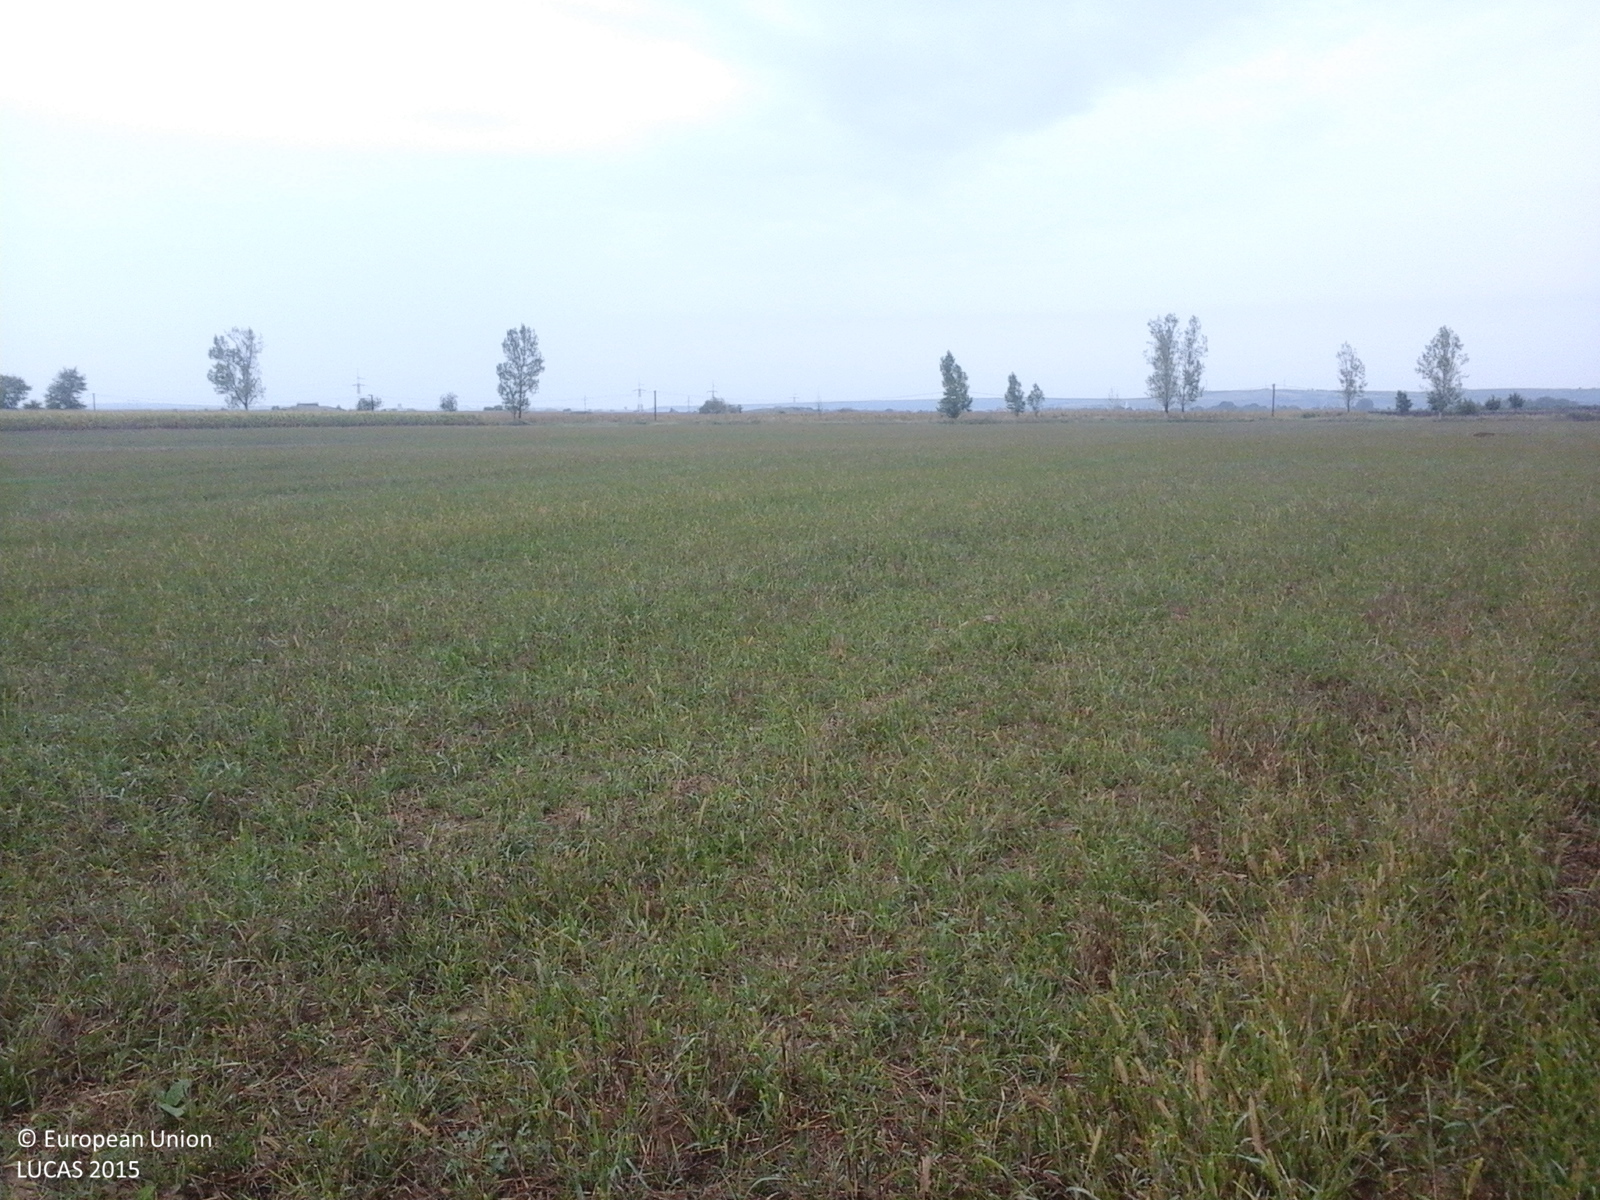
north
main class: Cropland
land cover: Common wheat
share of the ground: > 75 %
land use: Agriculture (excluding fallow land and kitchen gardens)
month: September
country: RO
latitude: 47.2908
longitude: 22.3375
